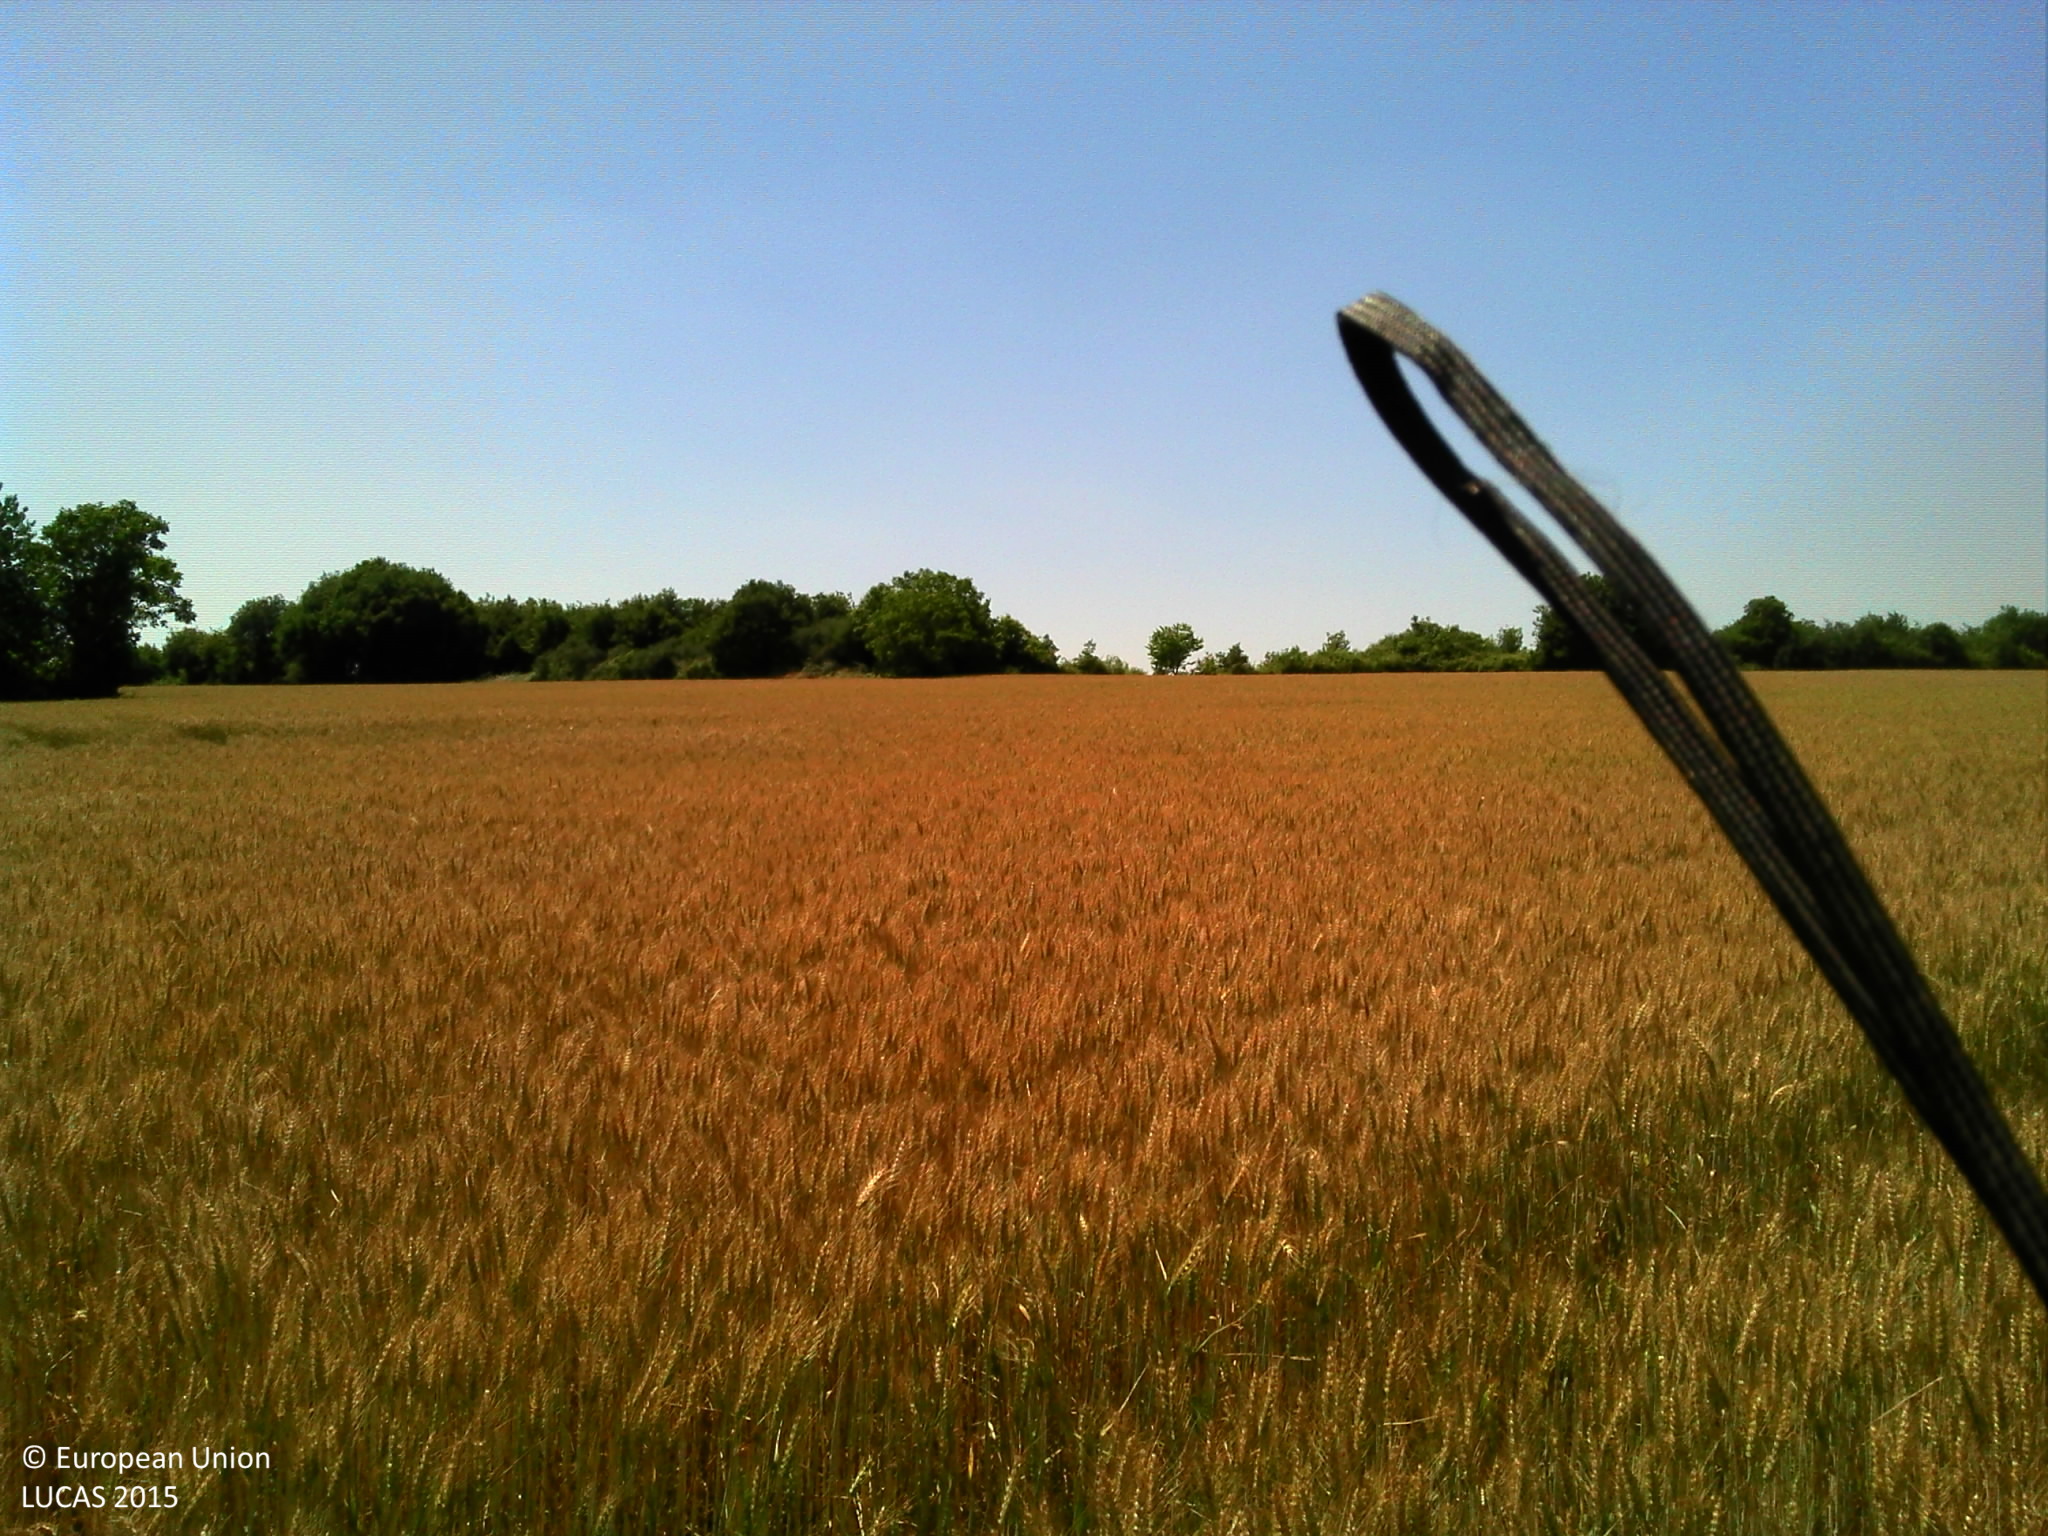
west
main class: Cropland
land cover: Common wheat
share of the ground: > 75 %
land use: Agriculture (excluding fallow land and kitchen gardens)
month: June
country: FR
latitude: 45.8970
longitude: 0.5642
